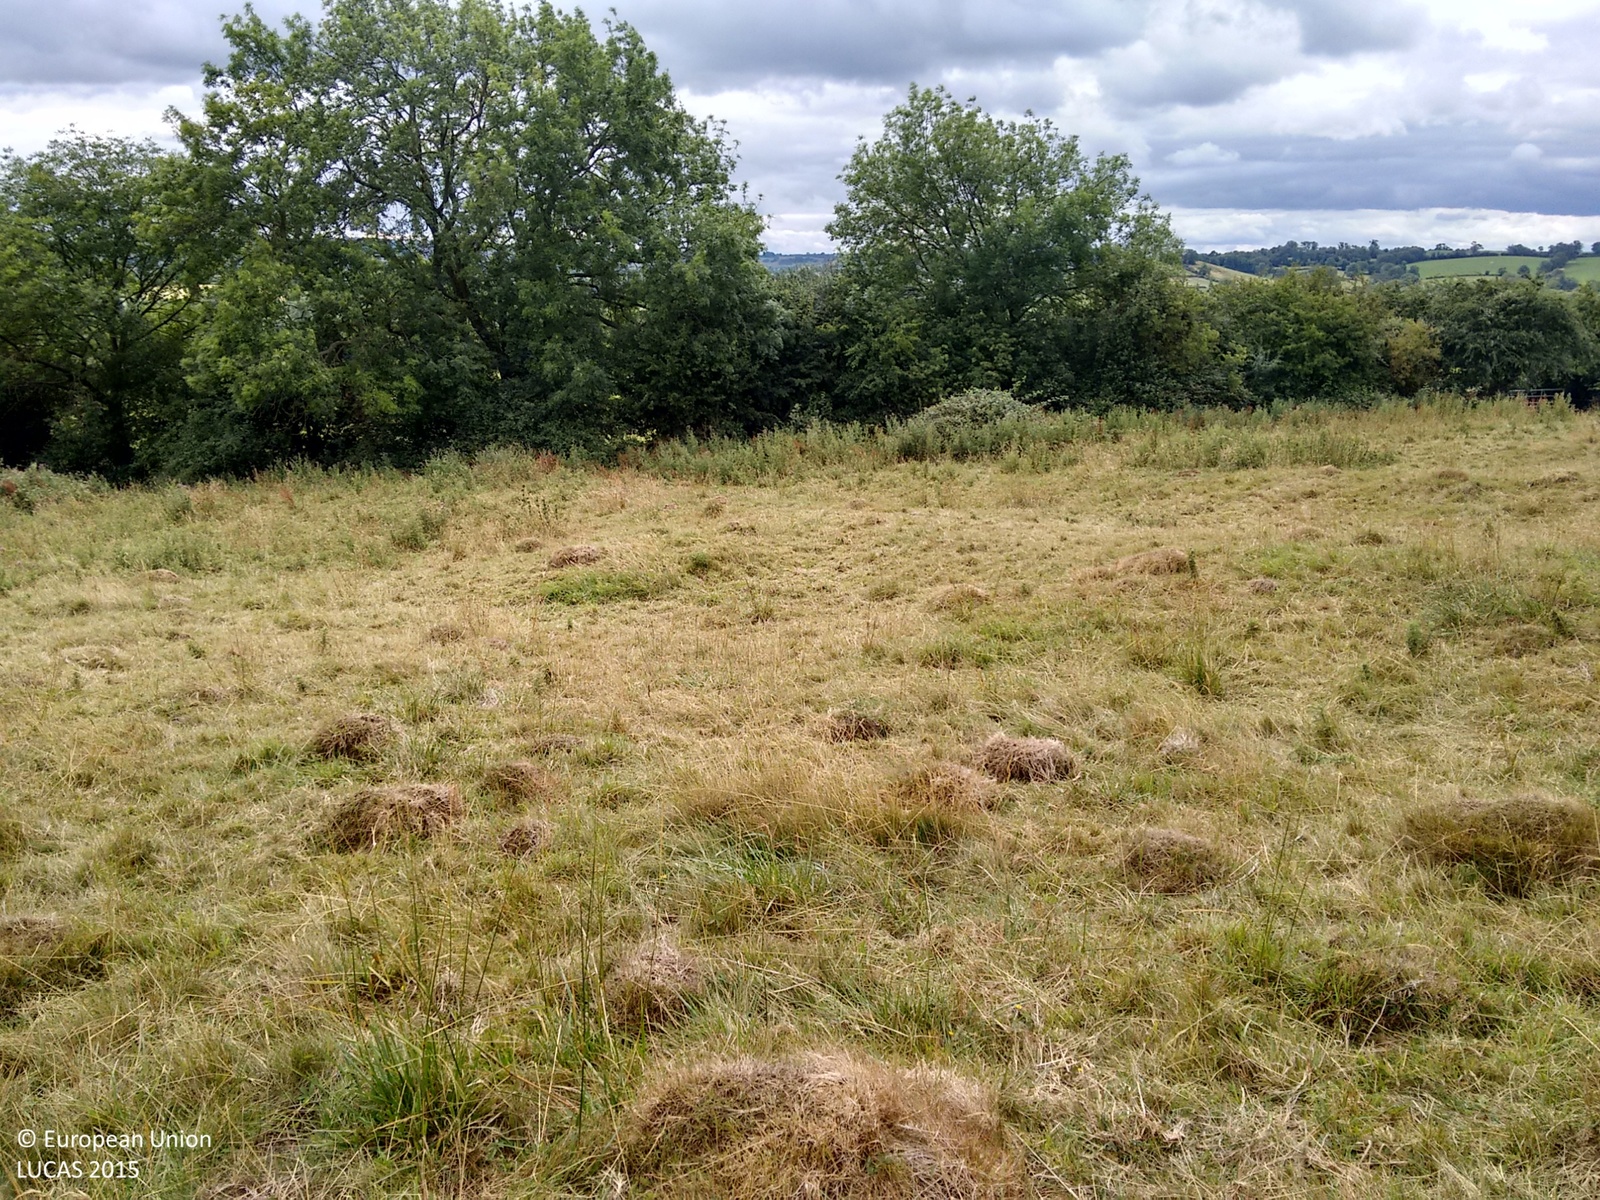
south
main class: Grassland
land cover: Grassland without tree/shrub cover
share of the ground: > 75 %
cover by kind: herbaceous plants 100 %
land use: Agriculture (excluding fallow land and kitchen gardens)
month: July
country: GB
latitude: 52.8459
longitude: -0.9866
